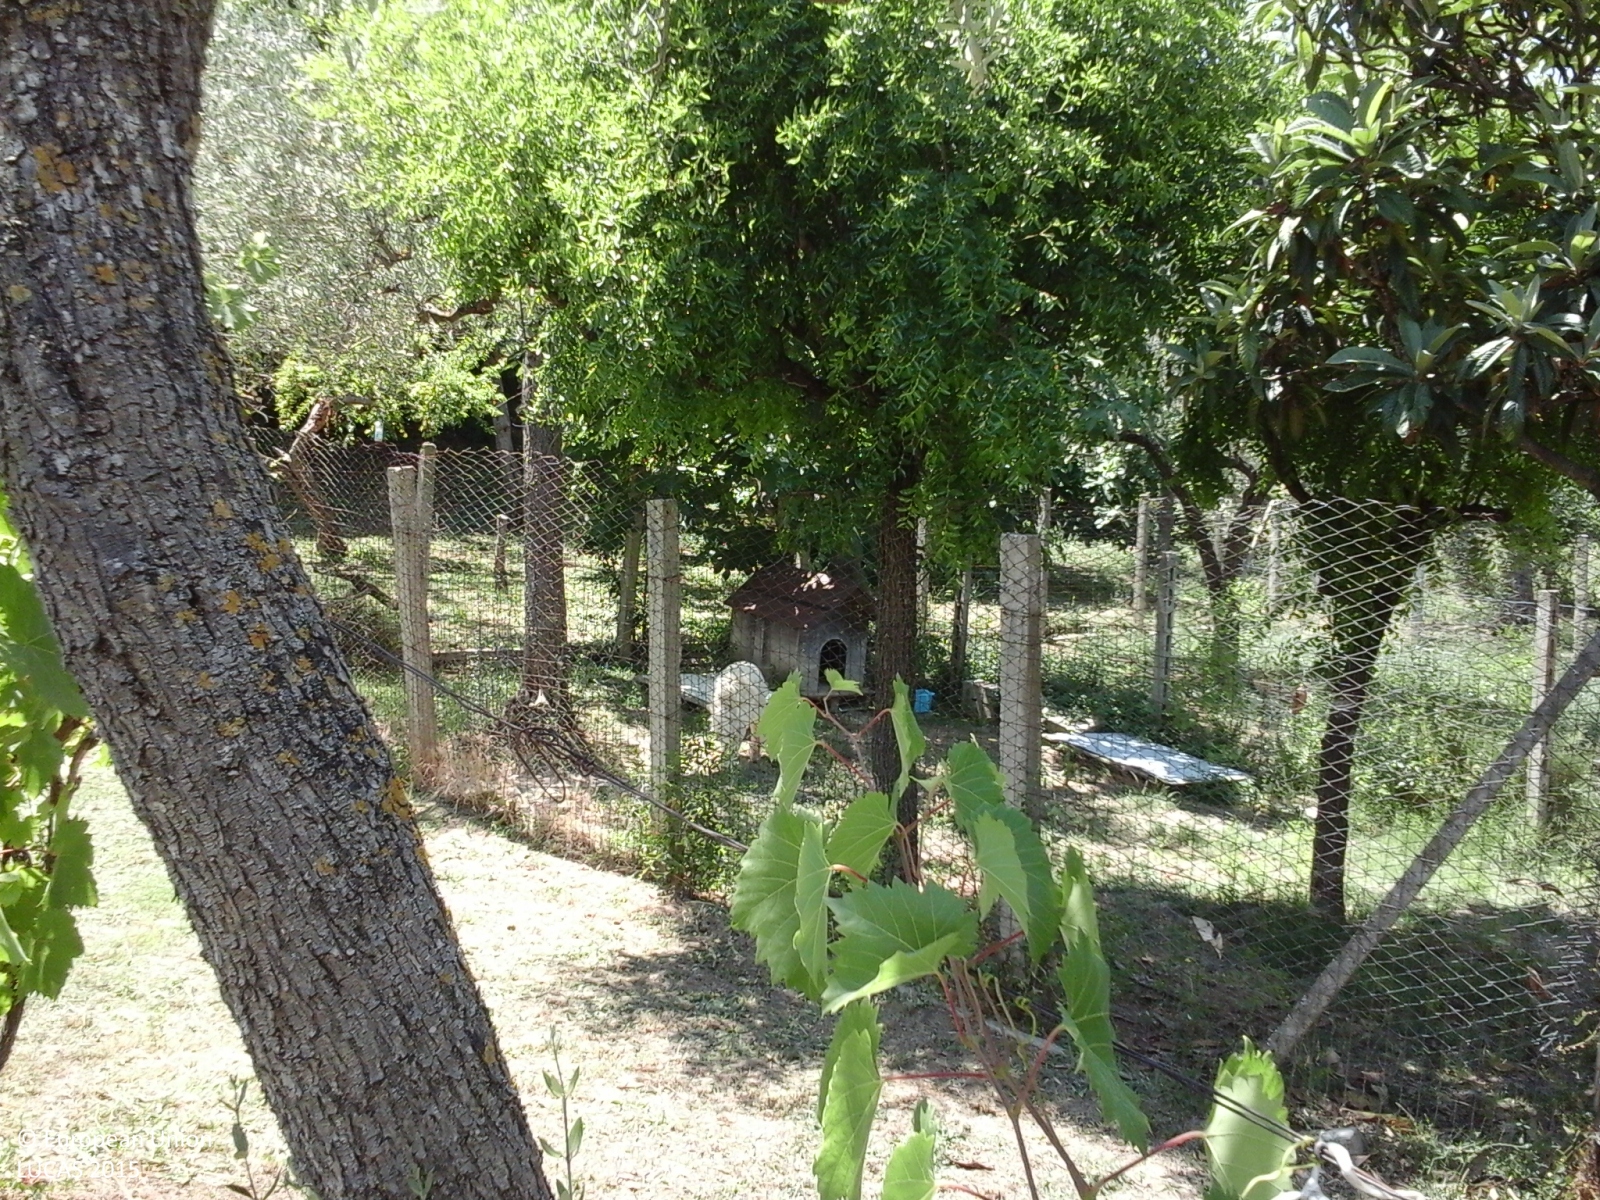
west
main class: Cropland
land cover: Olive groves
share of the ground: 25 - 50 %
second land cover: Other fresh vegetables
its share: 25 - 50 %
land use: Agriculture (excluding fallow land and kitchen gardens)
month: June
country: IT
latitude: 42.2345
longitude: 14.3610
